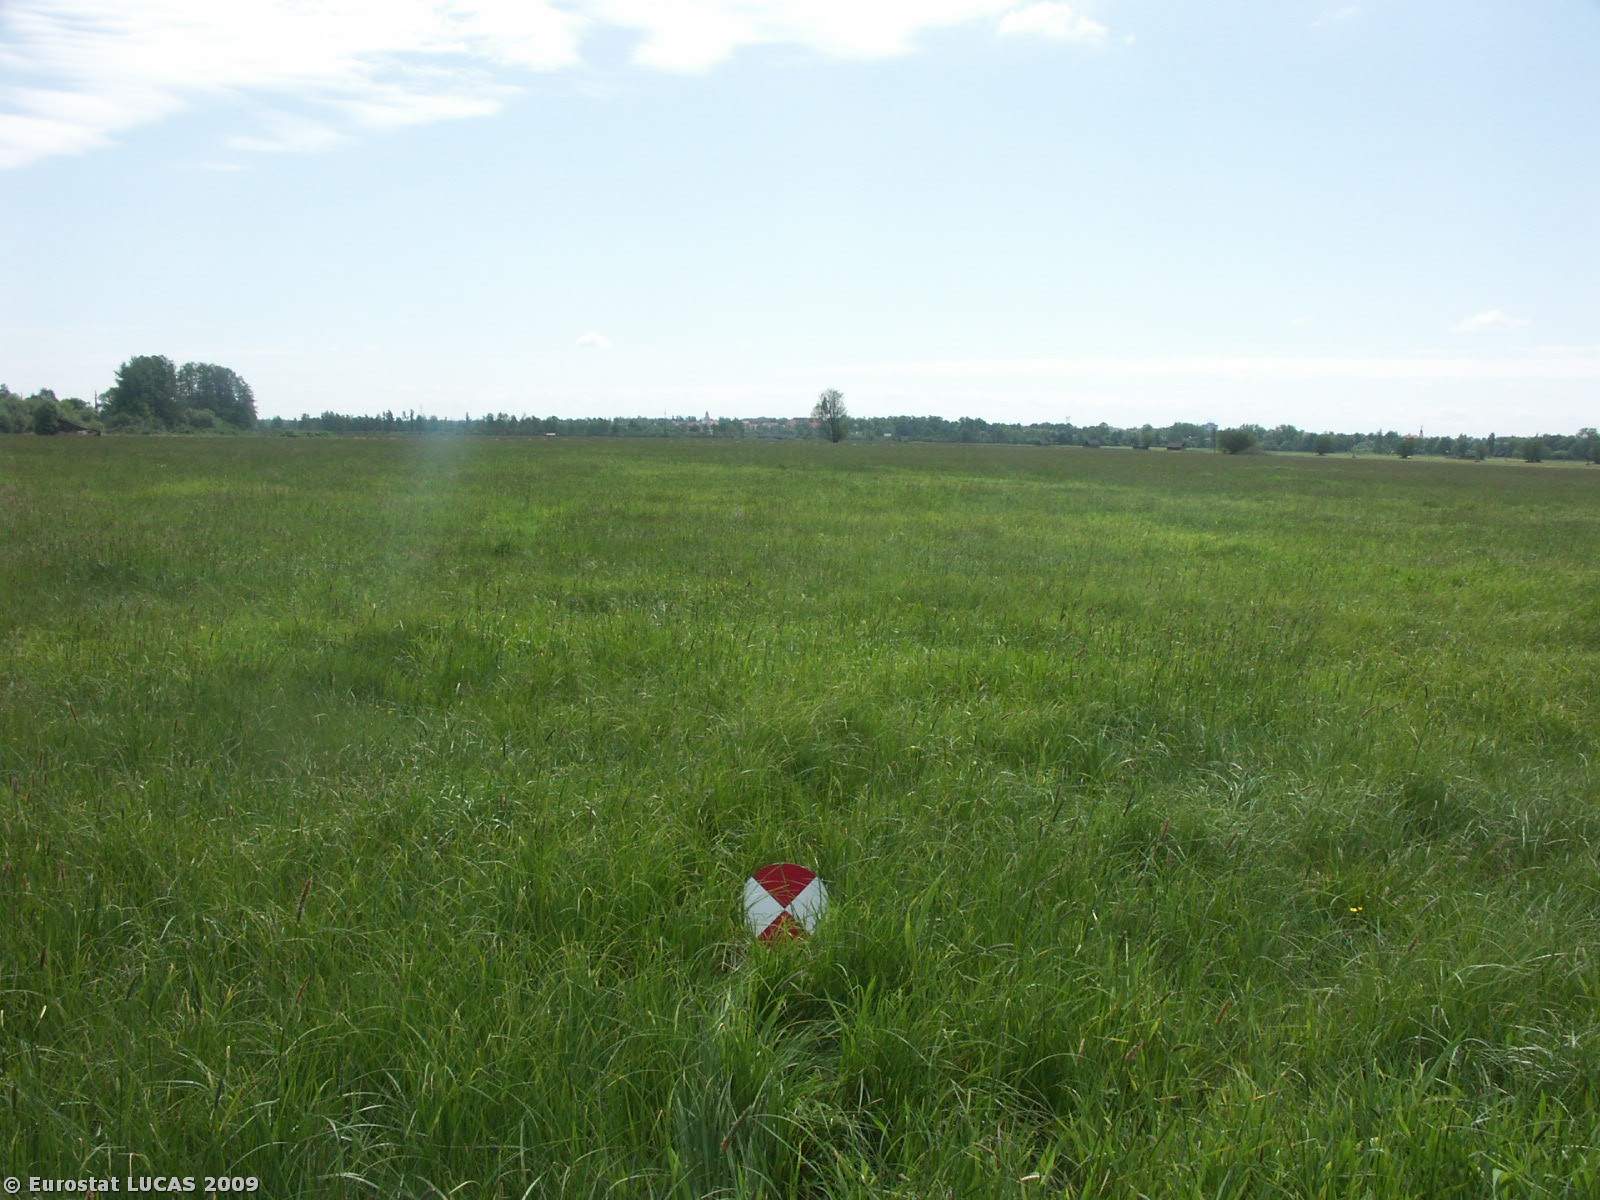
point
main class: Grassland
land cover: Grassland without tree/shrub cover
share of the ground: > 75 %
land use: Agriculture (excluding fallow land and kitchen gardens)
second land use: Nature reserves
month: May
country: CZ
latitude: 49.0213
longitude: 14.7741
